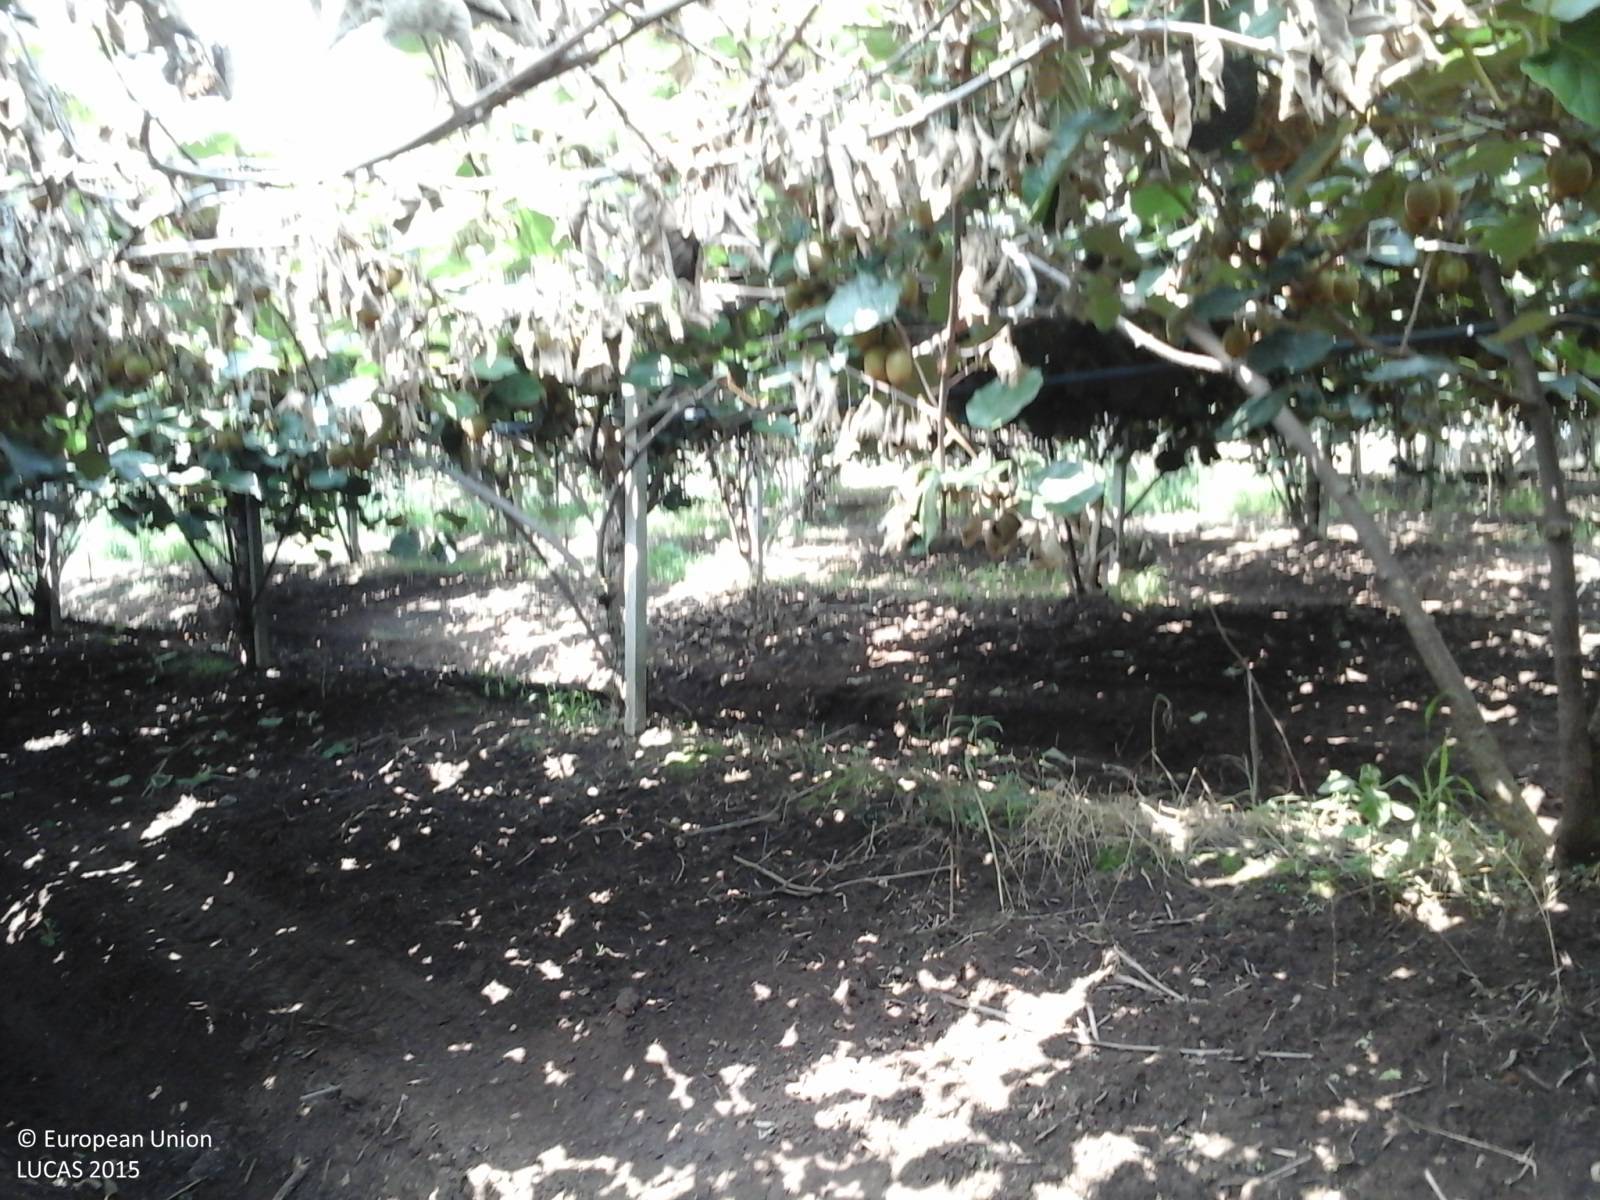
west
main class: Cropland
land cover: Other fruit trees and berries
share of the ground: > 75 %
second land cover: Other bare soil
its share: > 75 %
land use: Agriculture (excluding fallow land and kitchen gardens)
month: July
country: IT
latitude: 41.5505
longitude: 12.7346
